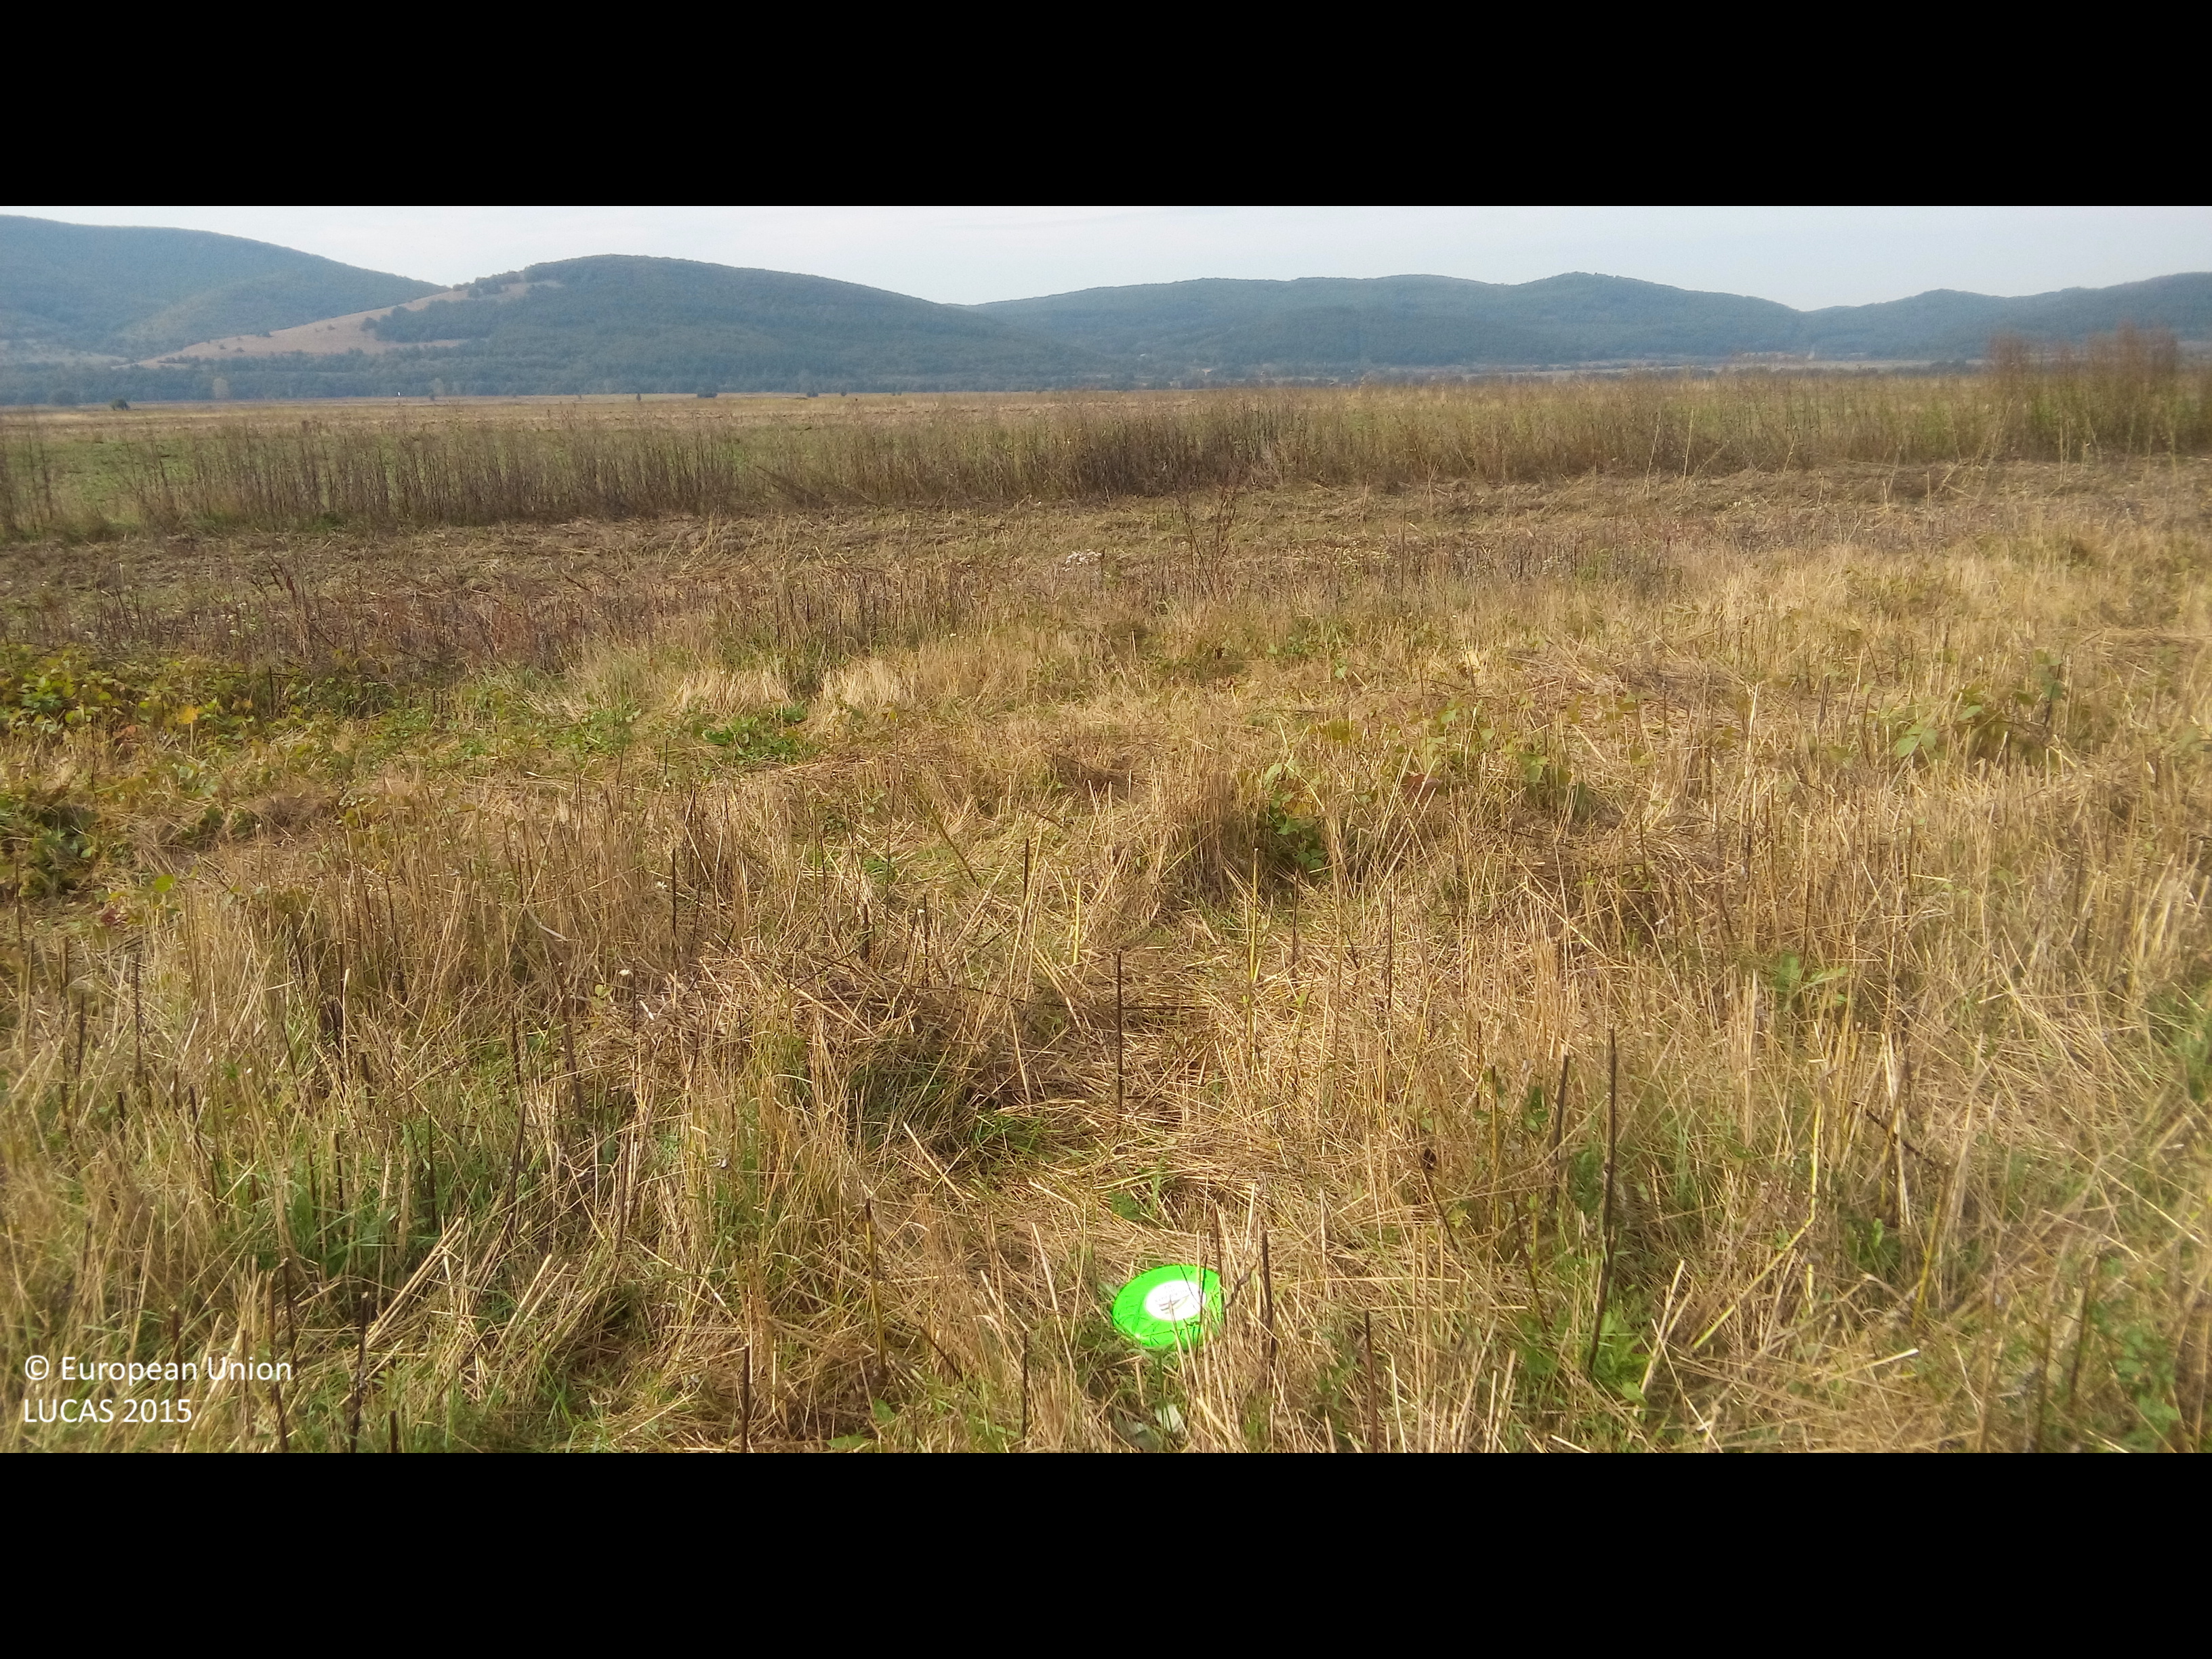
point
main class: Cropland
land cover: Common wheat
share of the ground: 50 - 75 %
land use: Agriculture (excluding fallow land and kitchen gardens)
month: October
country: BG
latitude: 42.7390
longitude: 23.8582
